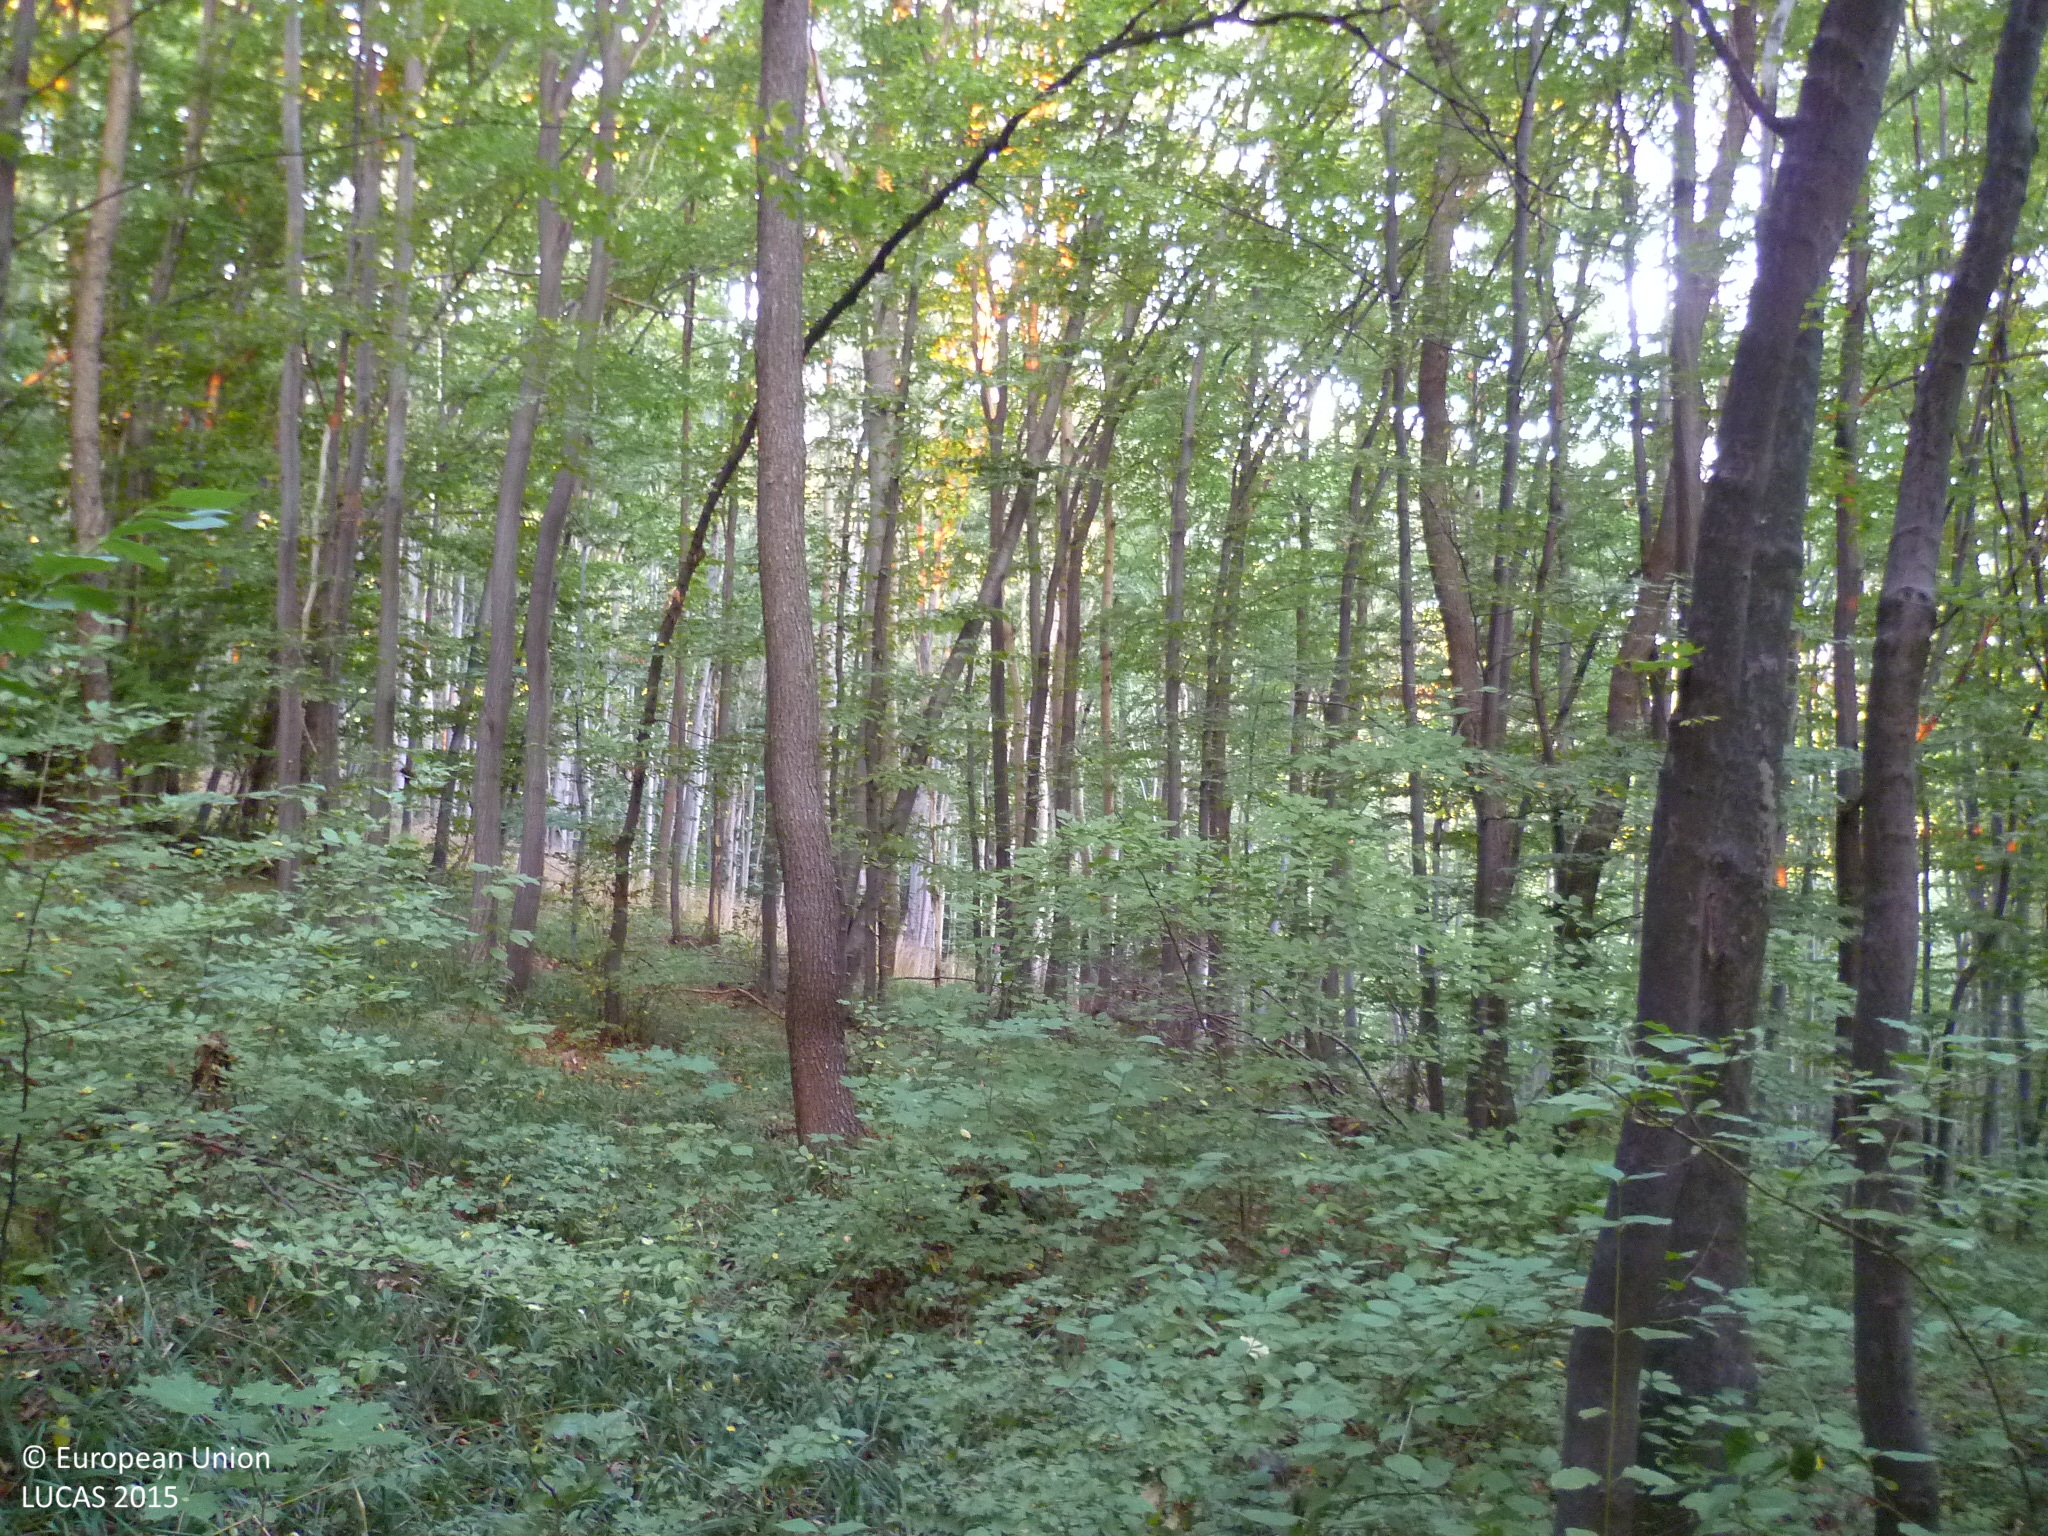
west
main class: Woodland
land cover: Broadleaved woodland
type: mesophytic deciduous forest
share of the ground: 50 - 75 %
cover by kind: broadleaved forest trees 65 %, herbaceous plants 30 %, shrubs 5 %
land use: Forestry
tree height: > 5 m
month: September
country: BG
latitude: 42.6666
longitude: 23.1723
